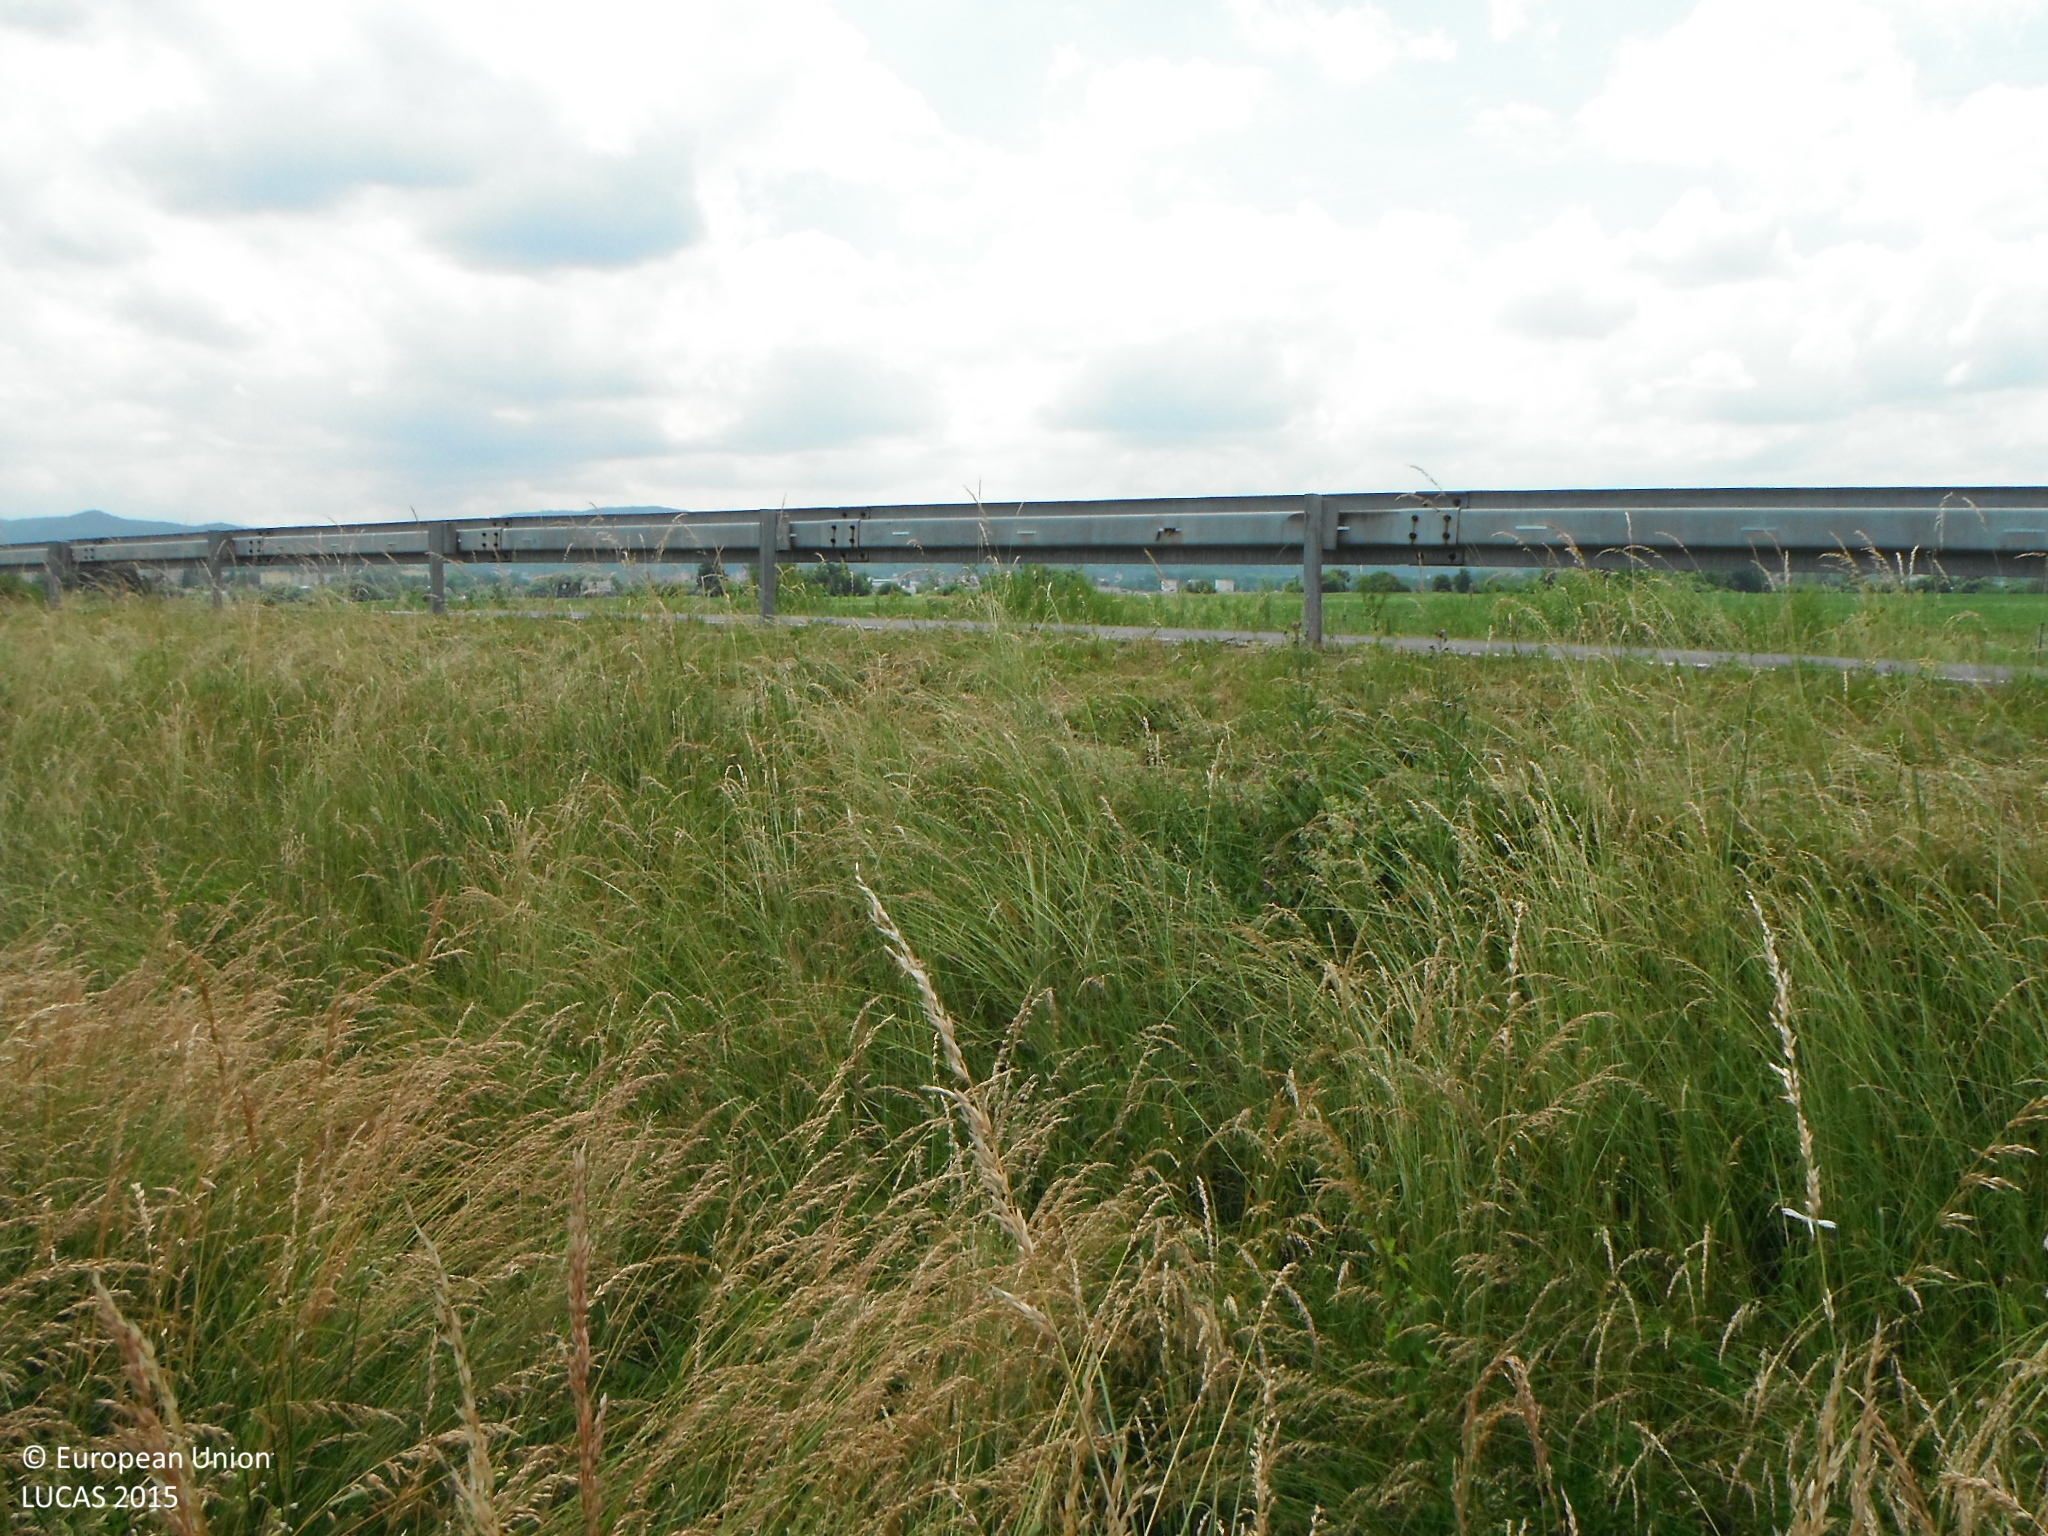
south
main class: Grassland
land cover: Grassland without tree/shrub cover
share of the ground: > 75 %
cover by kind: herbaceous plants 100 %
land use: Protection infrastructures
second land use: Road transport
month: June
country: SK
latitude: 48.6052
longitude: 19.1218
